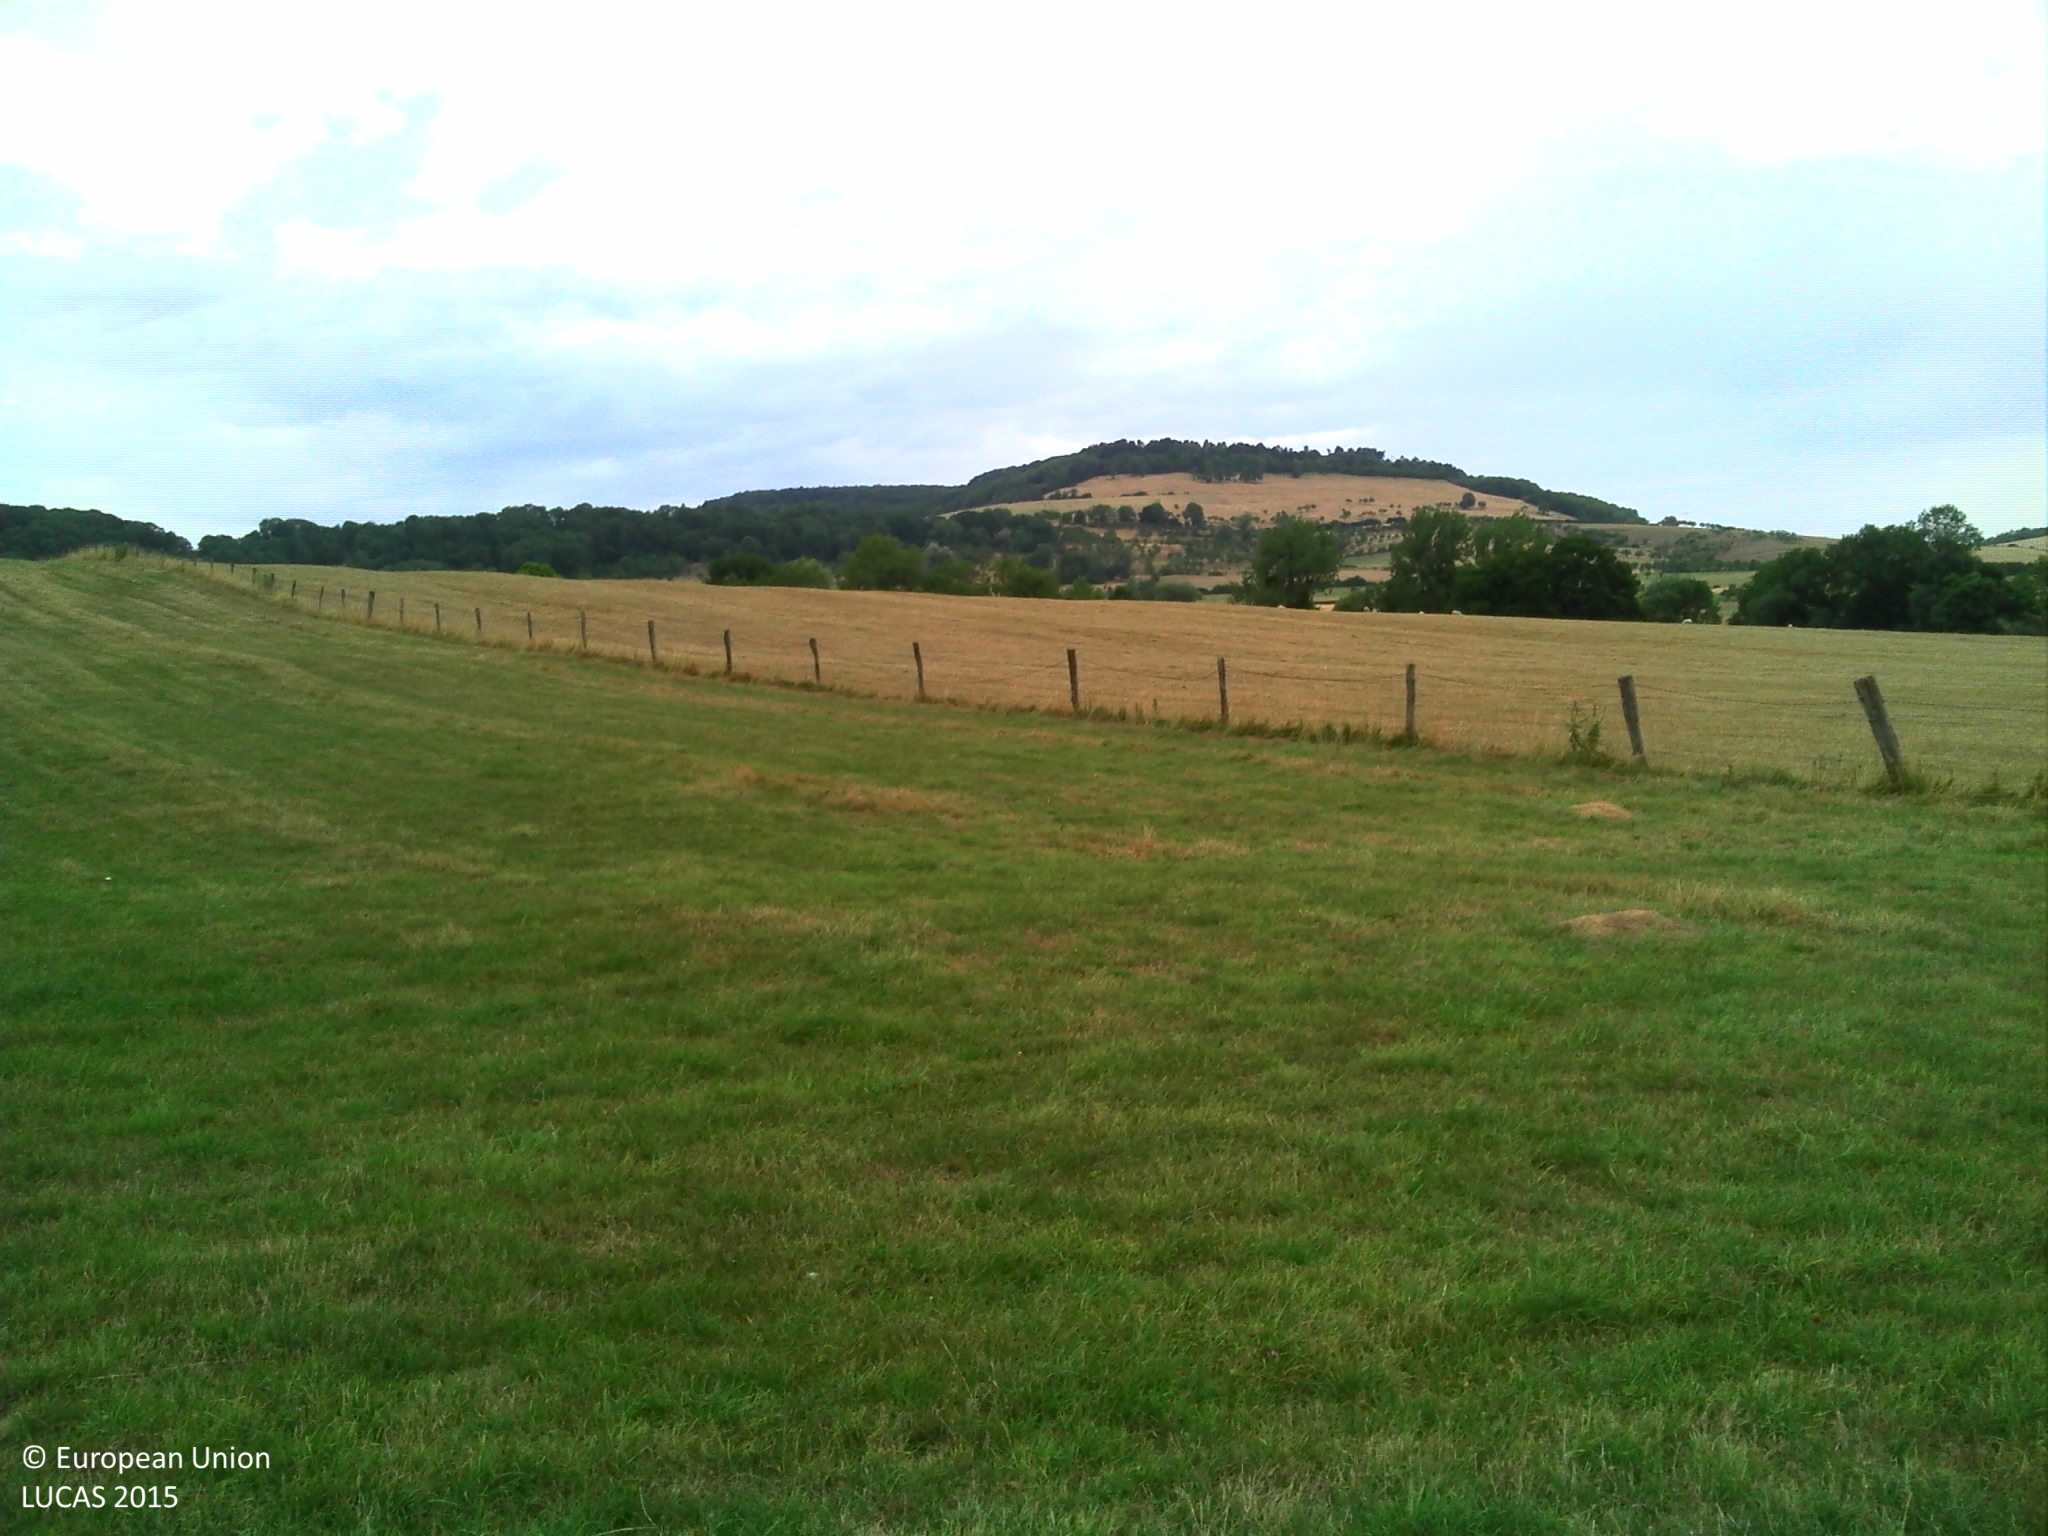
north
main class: Grassland
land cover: Grassland without tree/shrub cover
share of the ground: > 75 %
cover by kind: herbaceous plants 100 %
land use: Agriculture (excluding fallow land and kitchen gardens)
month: July
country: FR
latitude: 48.3688
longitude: 6.0450
